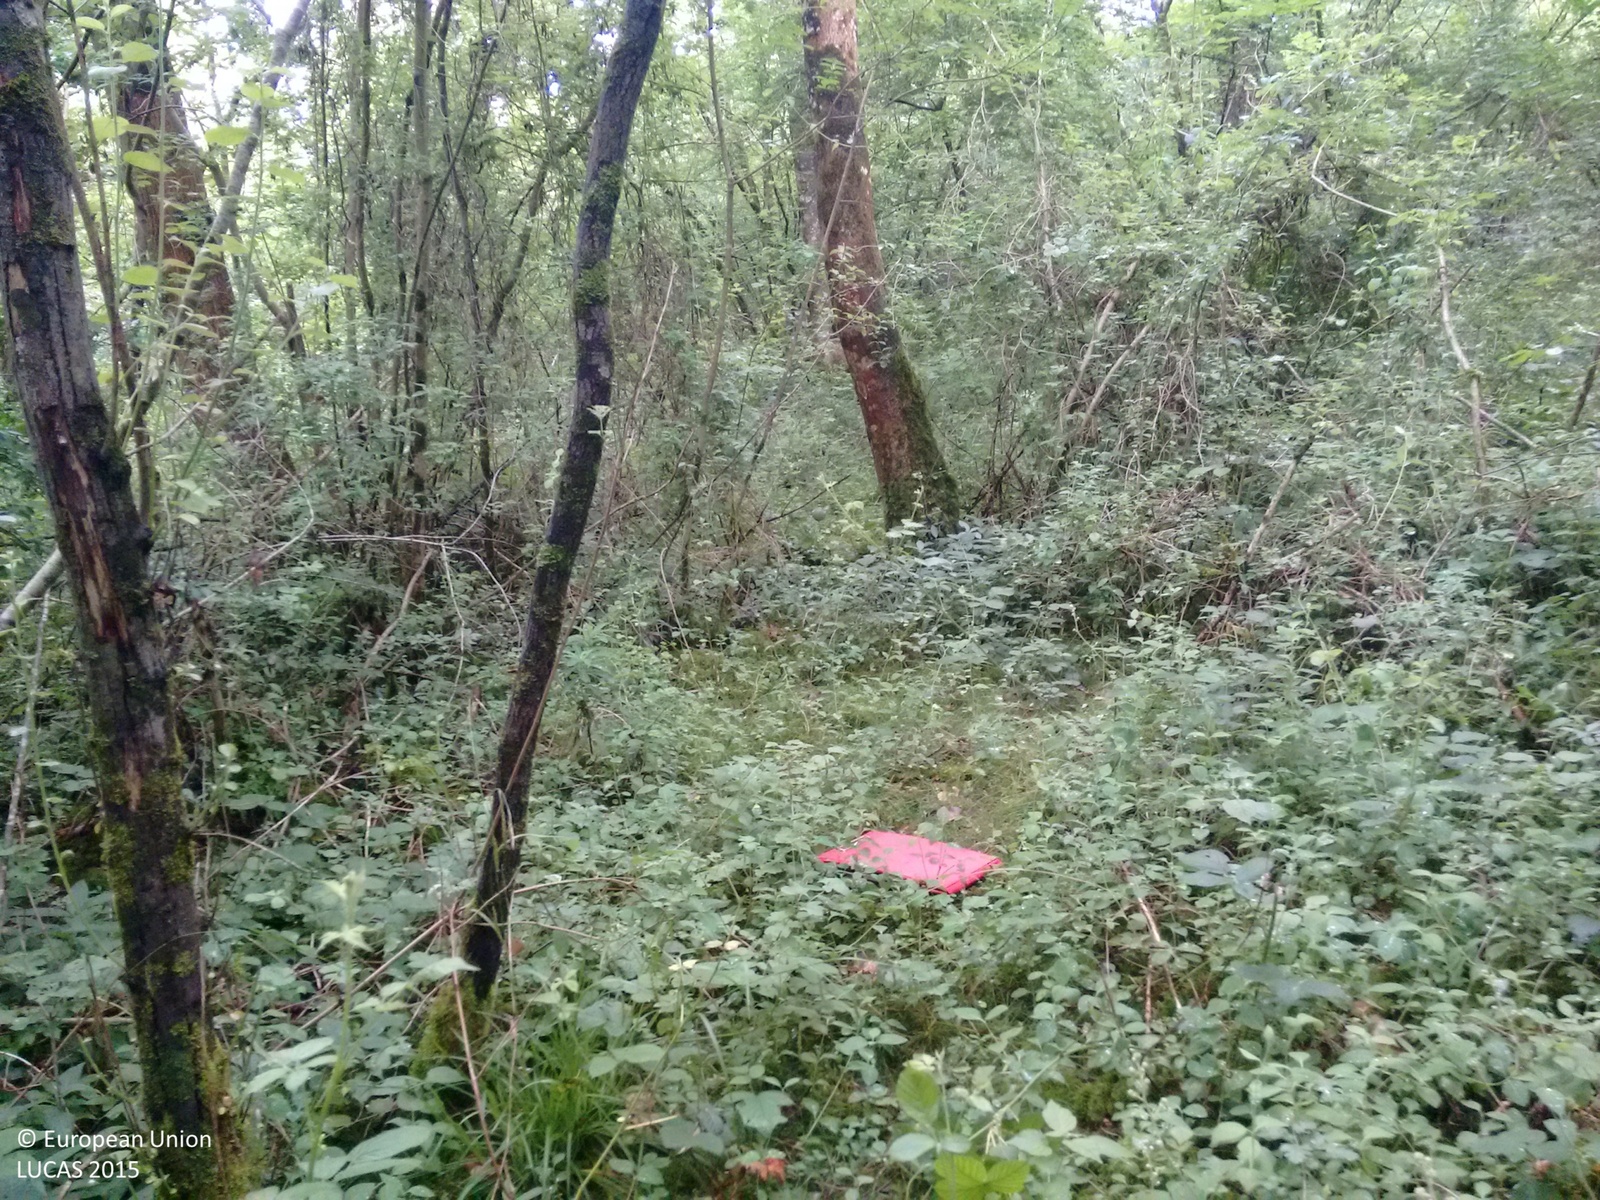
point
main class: Woodland
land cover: Broadleaved woodland
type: mesophytic deciduous forest
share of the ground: > 75 %
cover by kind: broadleaved forest trees 100 %
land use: Semi-natural and natural areas not in use
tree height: > 5 m
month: June
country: GB
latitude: 51.2364
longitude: -2.3675
